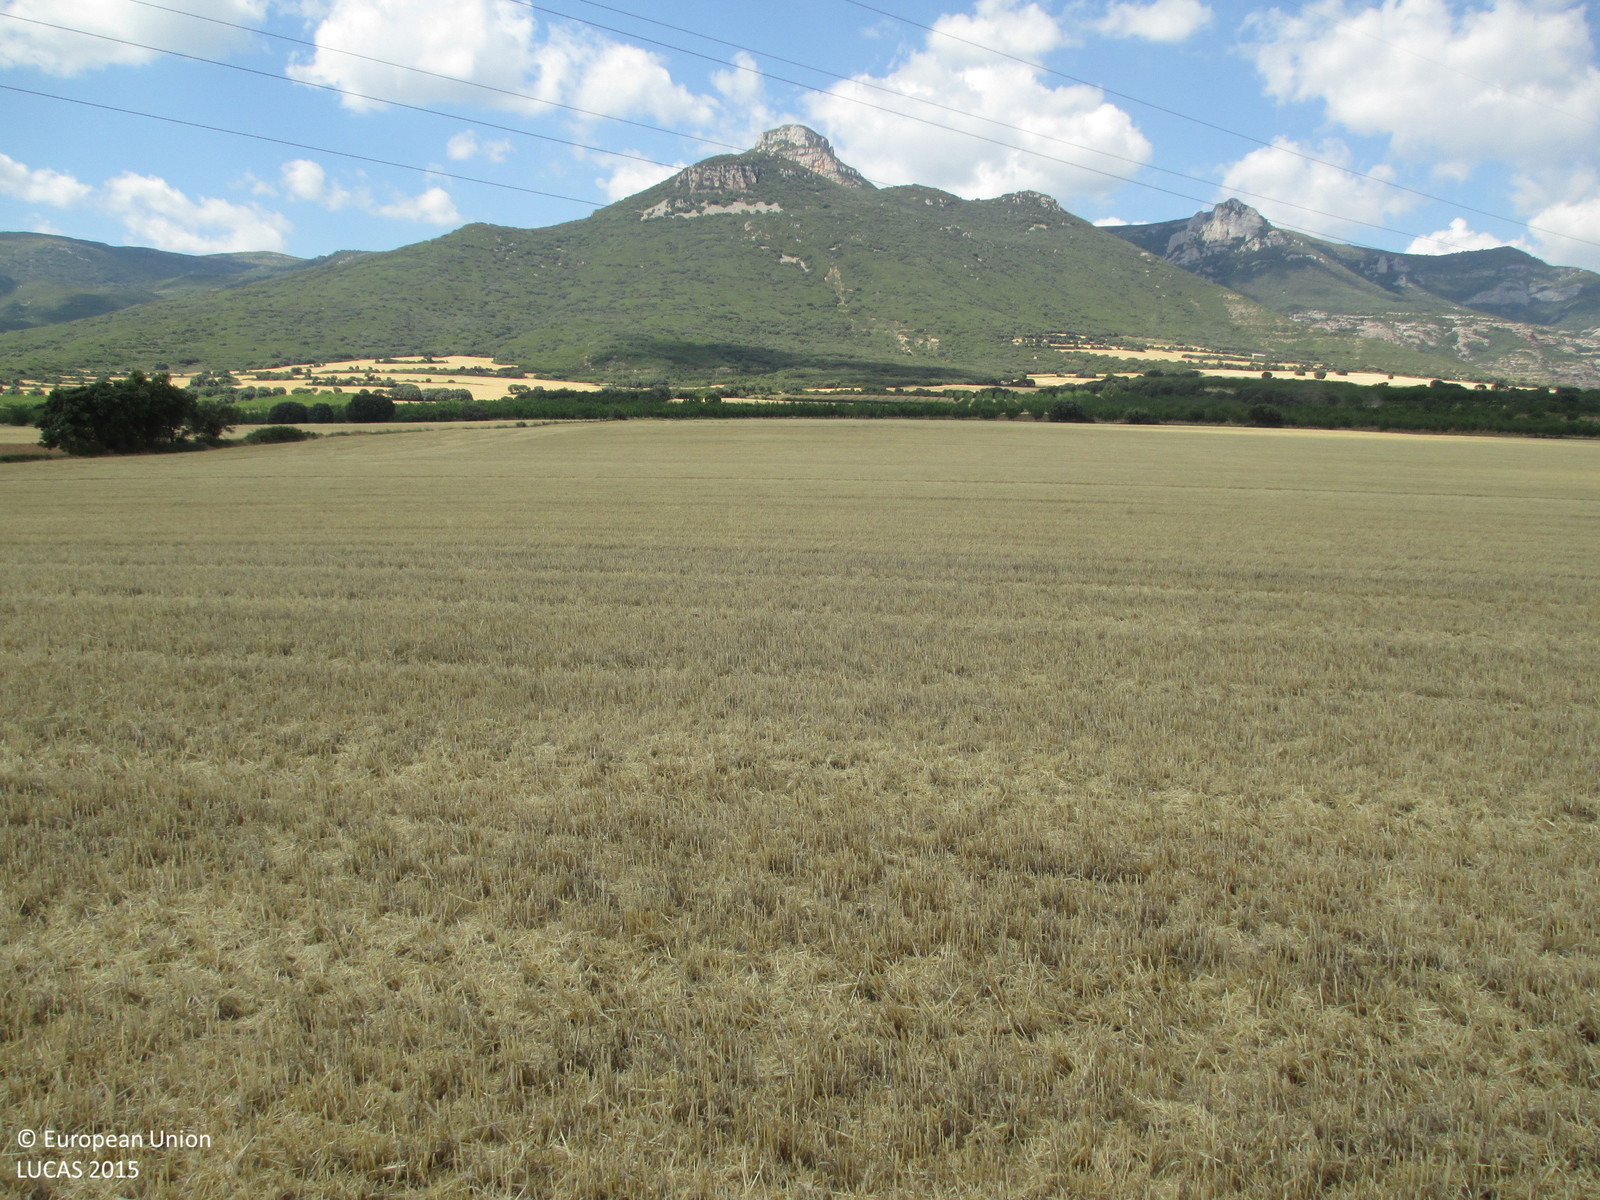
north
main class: Cropland
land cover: Barley
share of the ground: < 10 %
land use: Agriculture (excluding fallow land and kitchen gardens)
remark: Harvested field
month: June
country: ES
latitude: 42.2540
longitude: -0.4846
